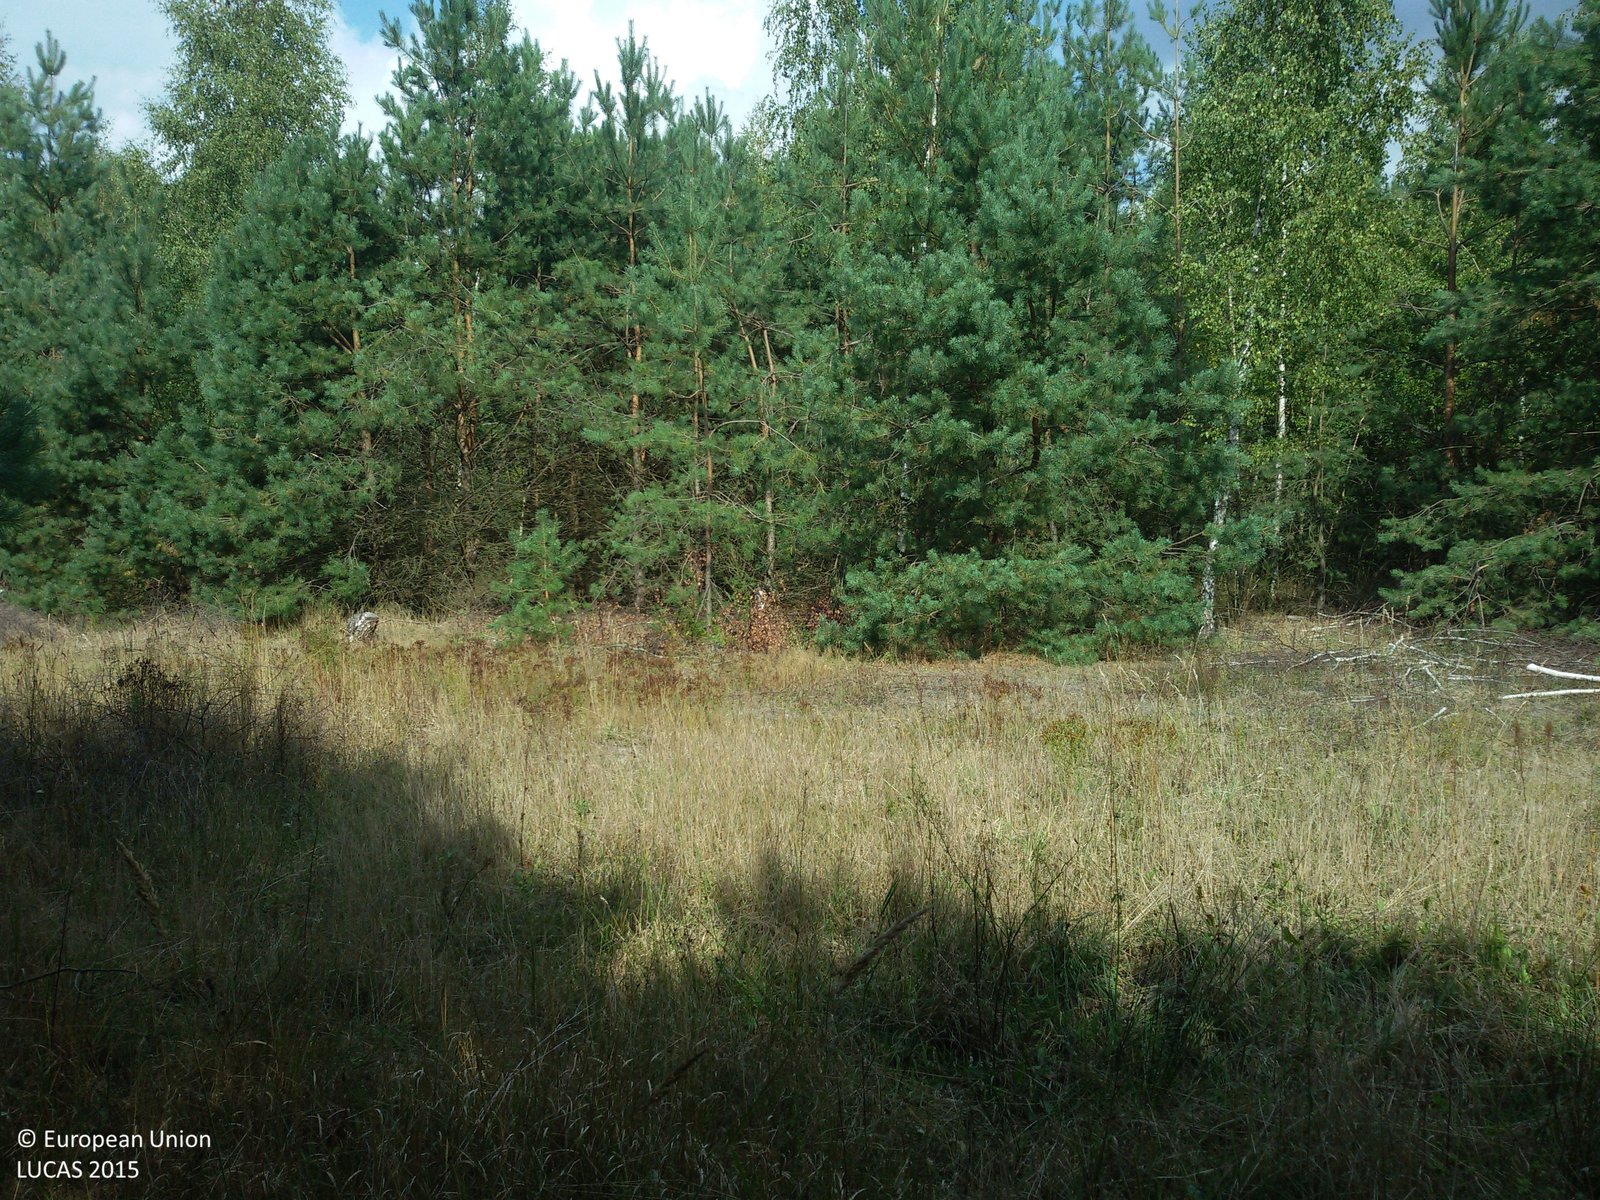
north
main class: Woodland
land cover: Pine dominated coniferous woodland
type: hemiboreal forest and nemoral coniferous forest and mixed broadleaved-coniferous forest
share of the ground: > 75 %
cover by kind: coniferous forest trees 90 %, herbaceous plants 5 %, unconsolidated bare surface 5 %
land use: Forestry
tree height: > 5 m
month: September
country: PL
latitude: 51.3766
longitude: 18.8577
